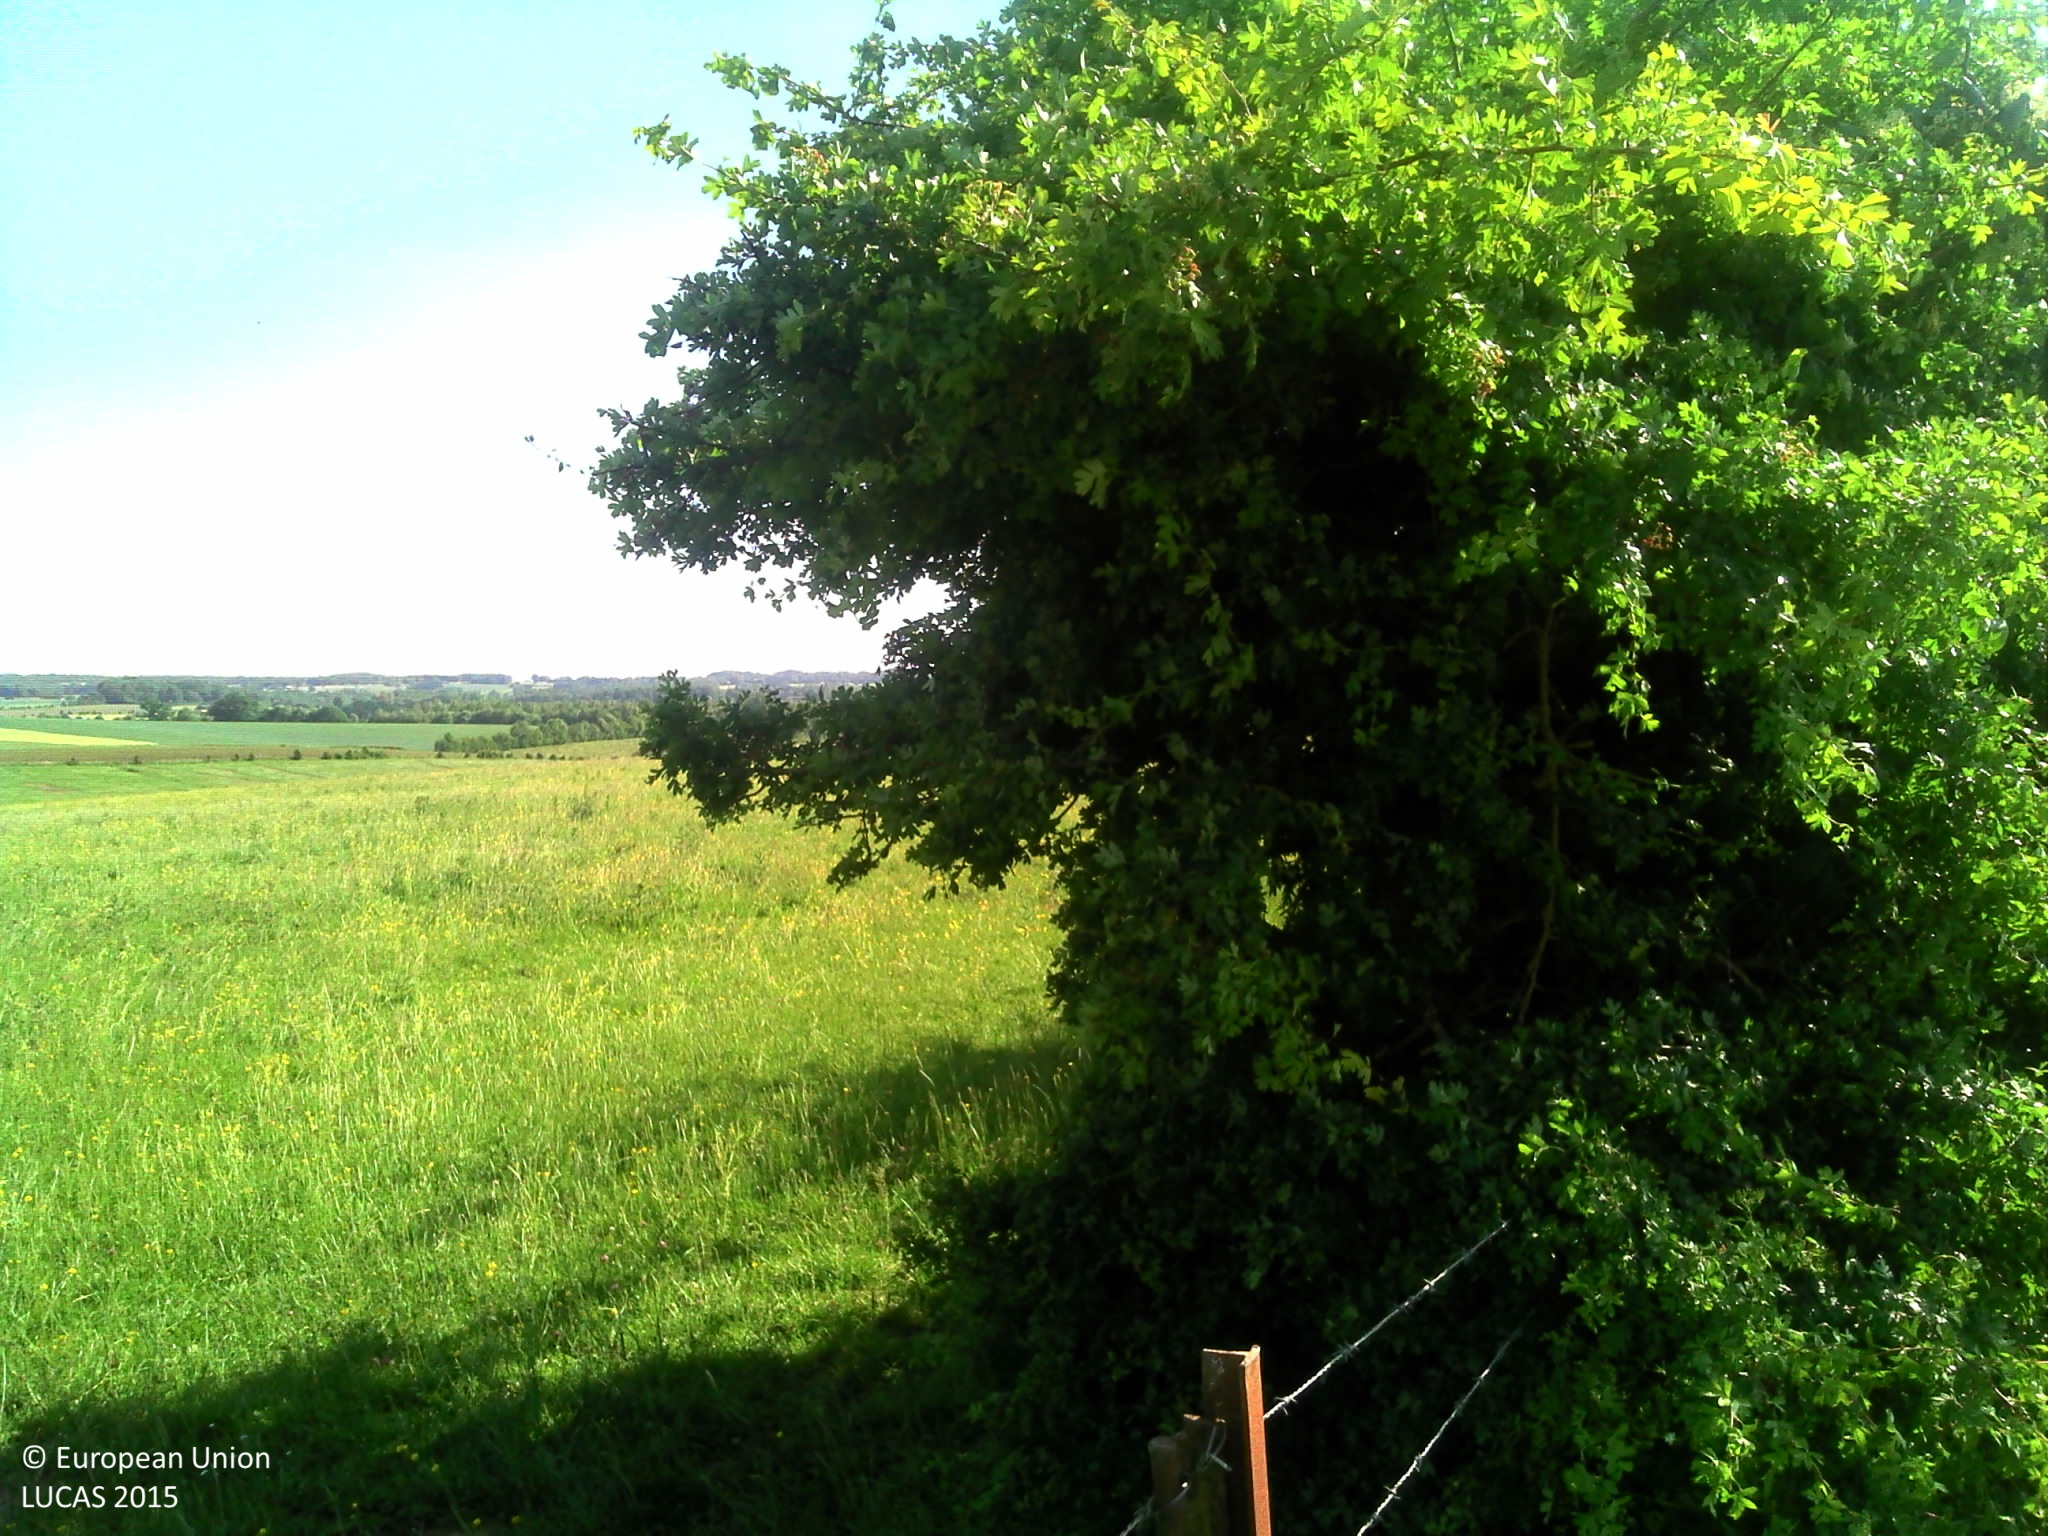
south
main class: Grassland
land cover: Grassland without tree/shrub cover
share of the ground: > 75 %
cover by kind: herbaceous plants 100 %
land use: Agriculture (excluding fallow land and kitchen gardens)
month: June
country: FR
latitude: 49.8862
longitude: 4.0795
